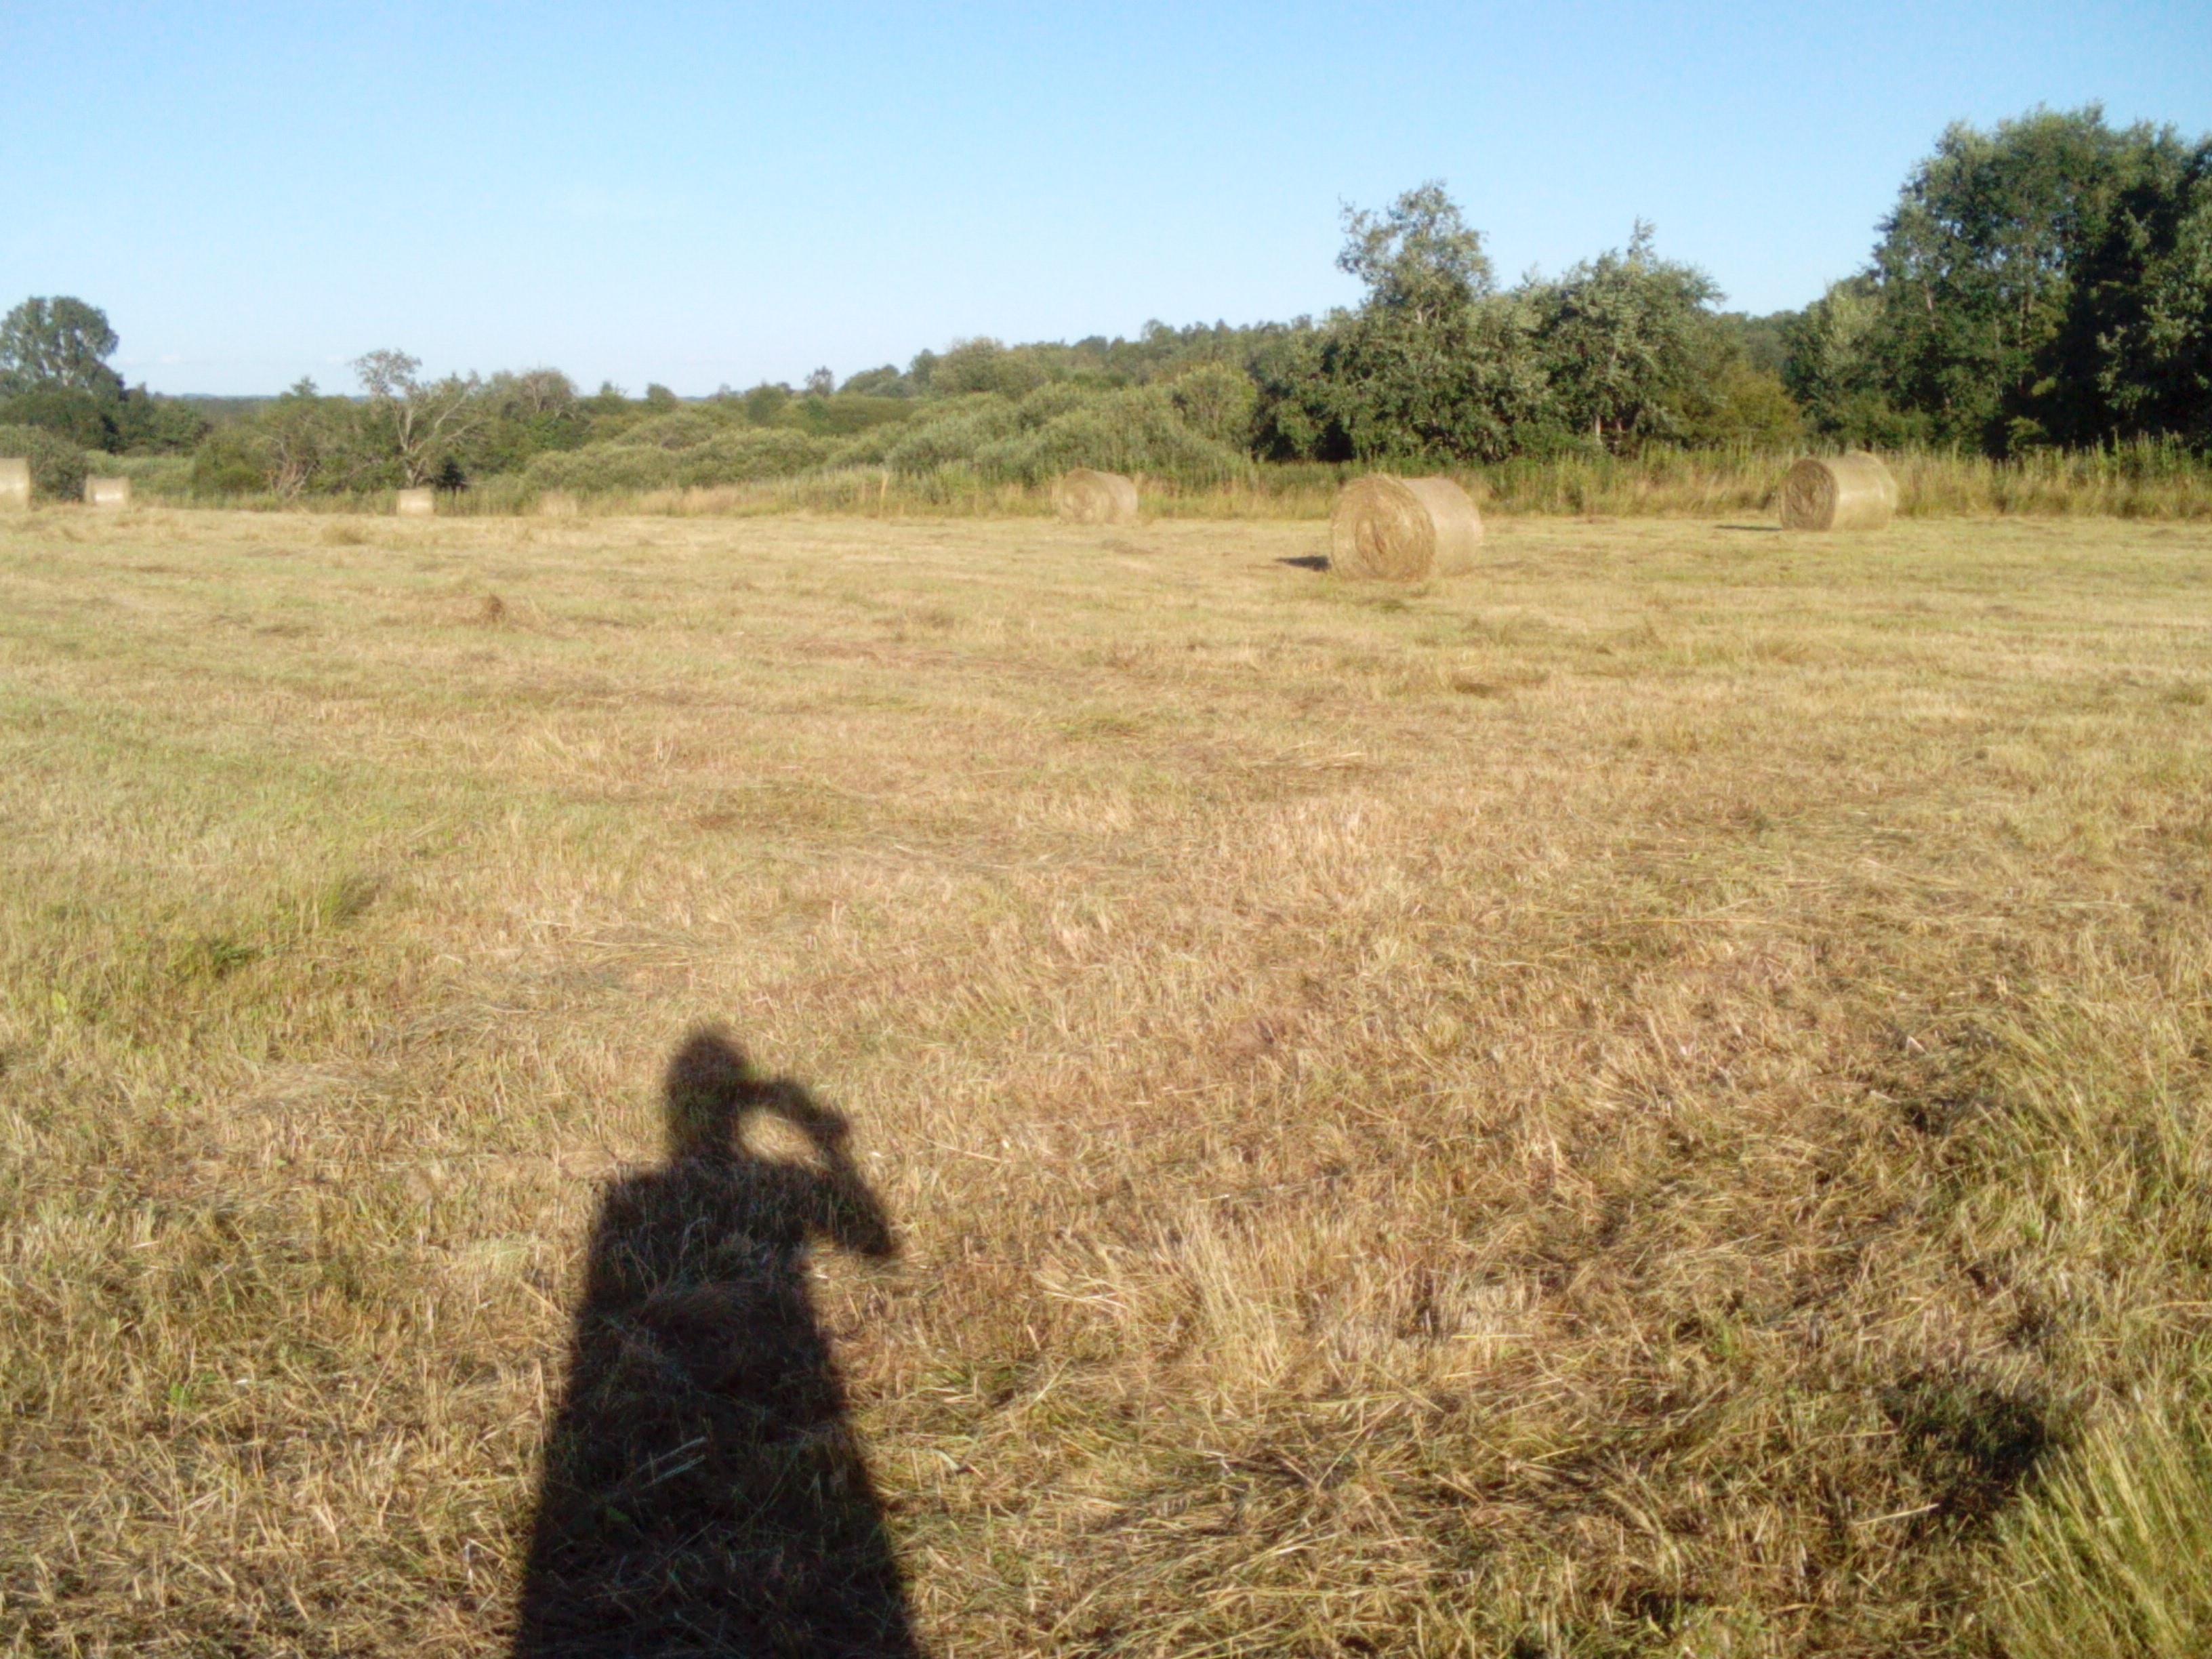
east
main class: Grassland
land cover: Grassland without tree/shrub cover
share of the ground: > 75 %
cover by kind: herbaceous plants 100 %
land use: Agriculture (excluding fallow land and kitchen gardens)
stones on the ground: < 10 %
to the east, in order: Grassland without tree/shrub cover; Broadleaved woodland; Grassland without tree/shrub cover; Spontaneously vegetated surfaces; Rivers and streams; Grassland with sparse tree/shrub cover
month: August
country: LV
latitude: 56.5523
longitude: 21.3790
